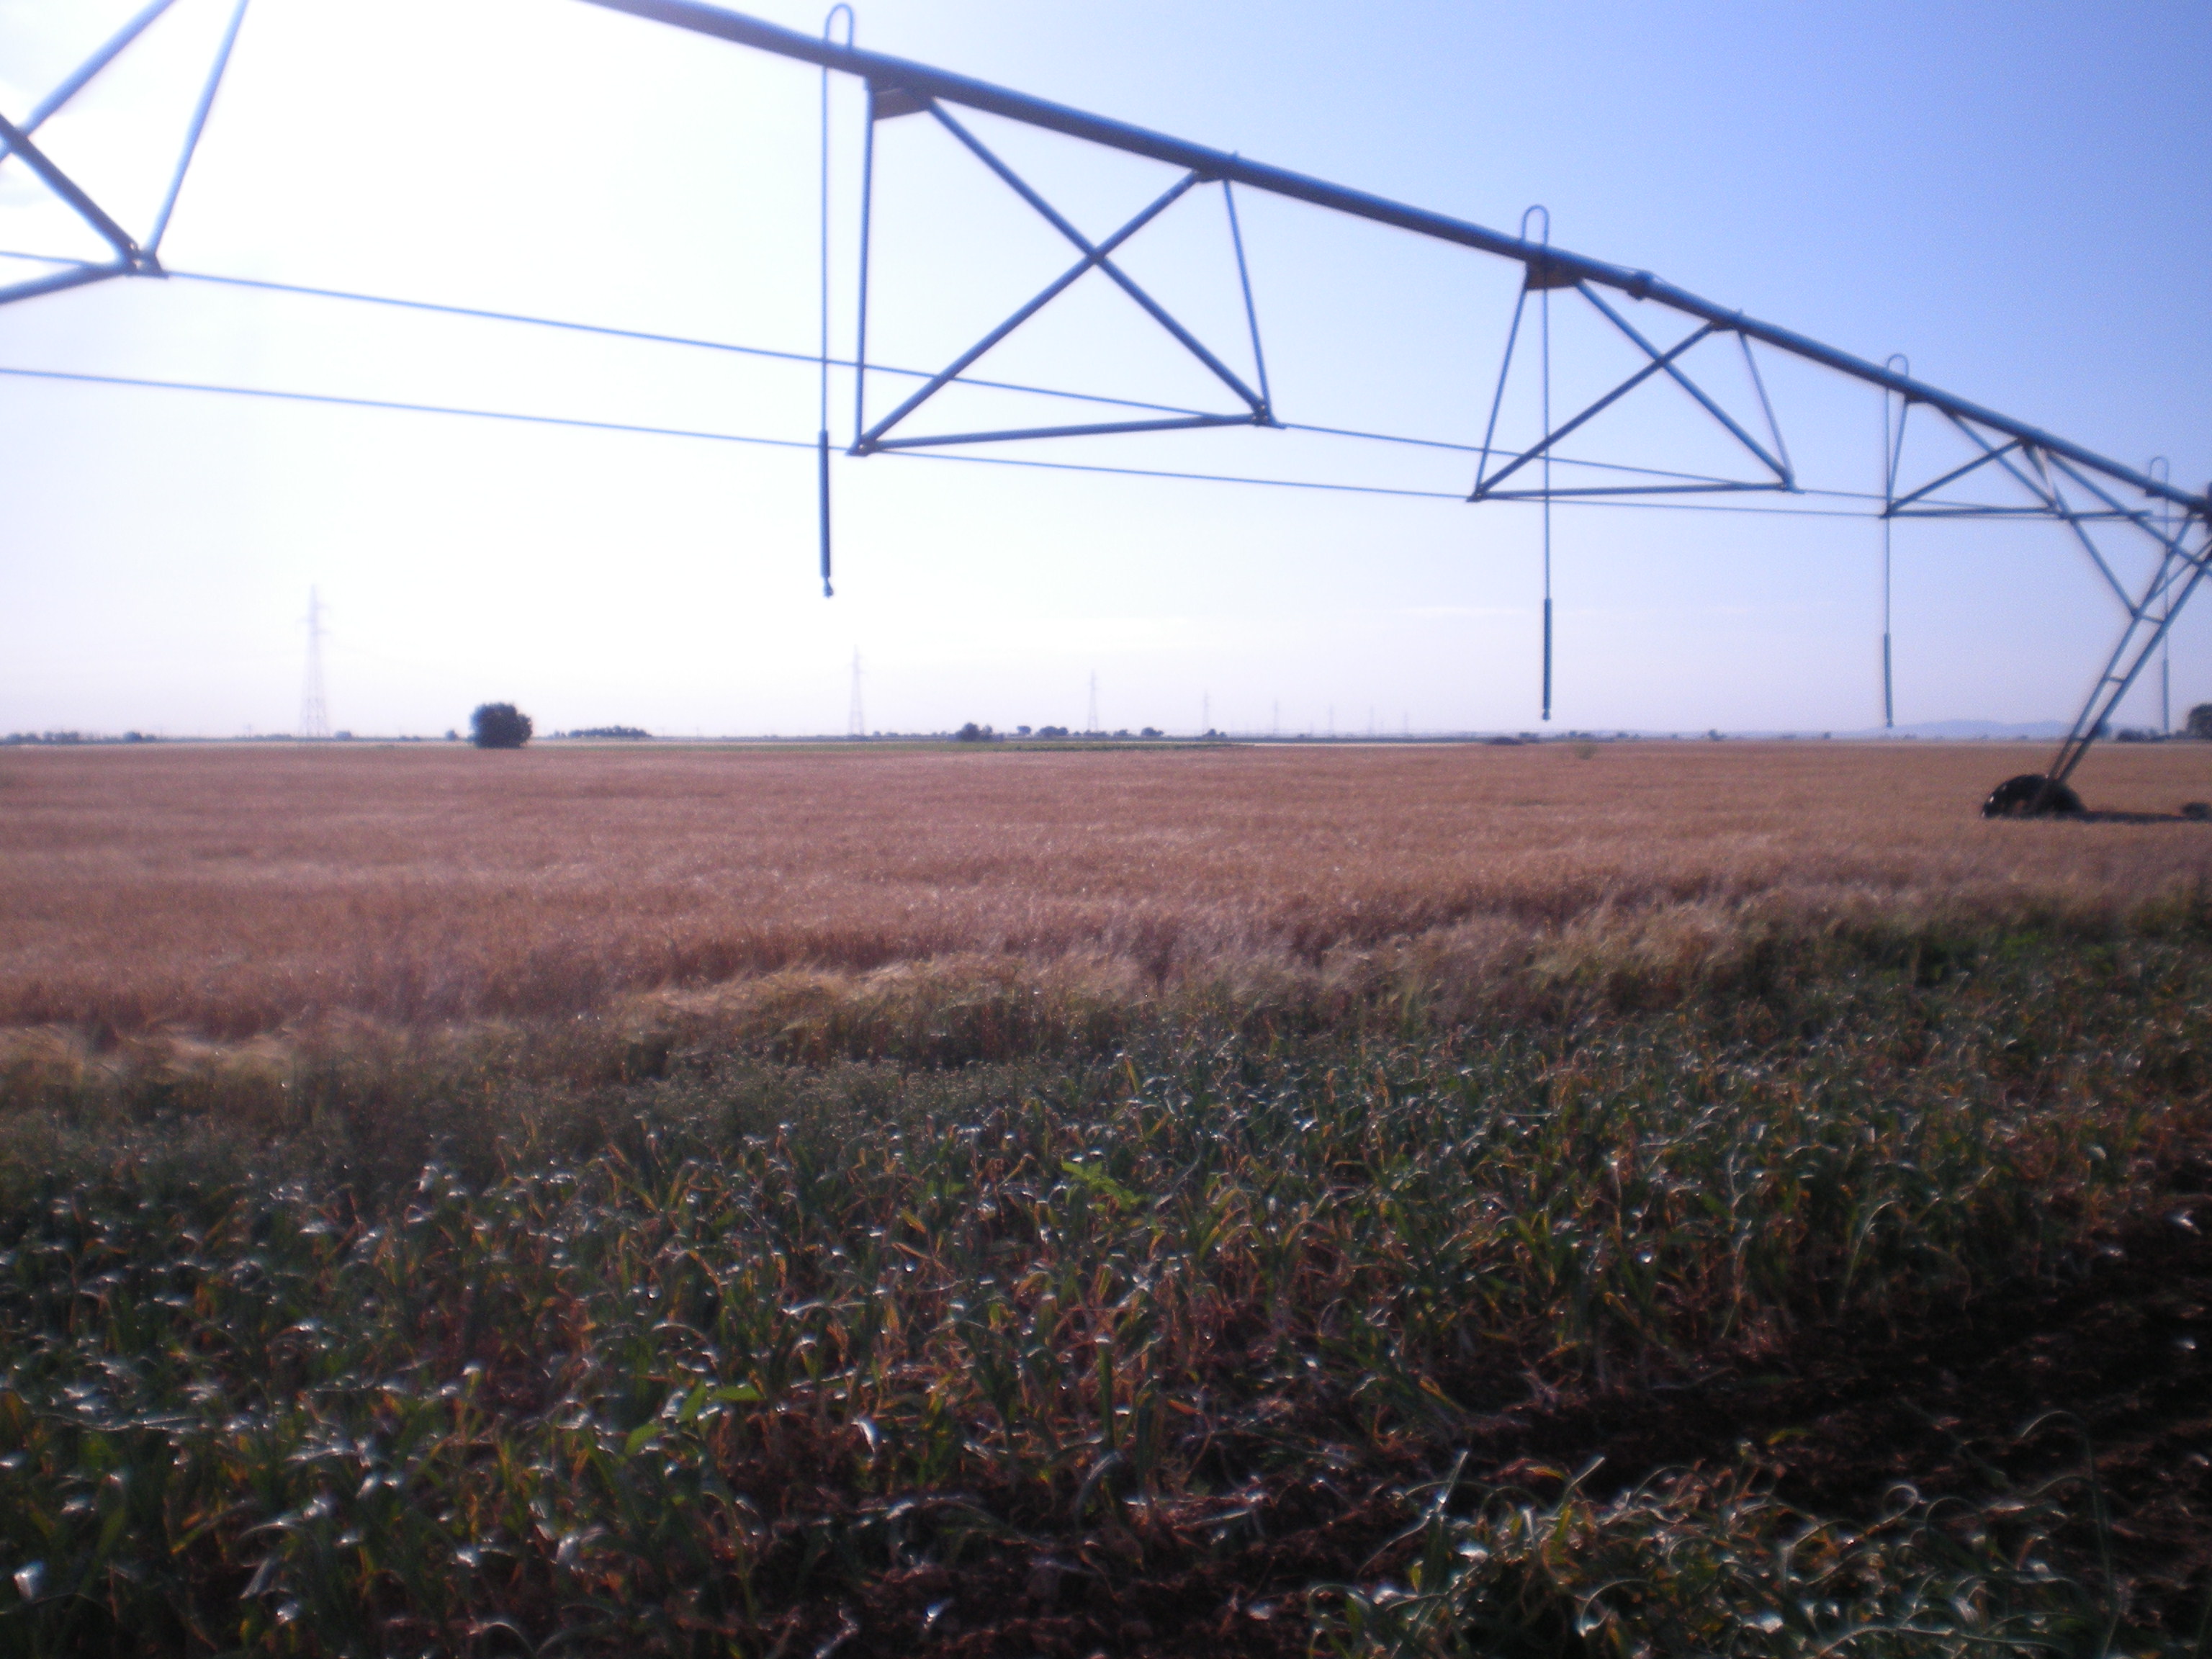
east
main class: Cropland
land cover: Other root crops
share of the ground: 50 - 75 %
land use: Agriculture (excluding fallow land and kitchen gardens)
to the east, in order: Other root crops; Other bare soil; Other root crops; Grass margins; Barley
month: May
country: ES
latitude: 39.0334
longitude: -3.5208
